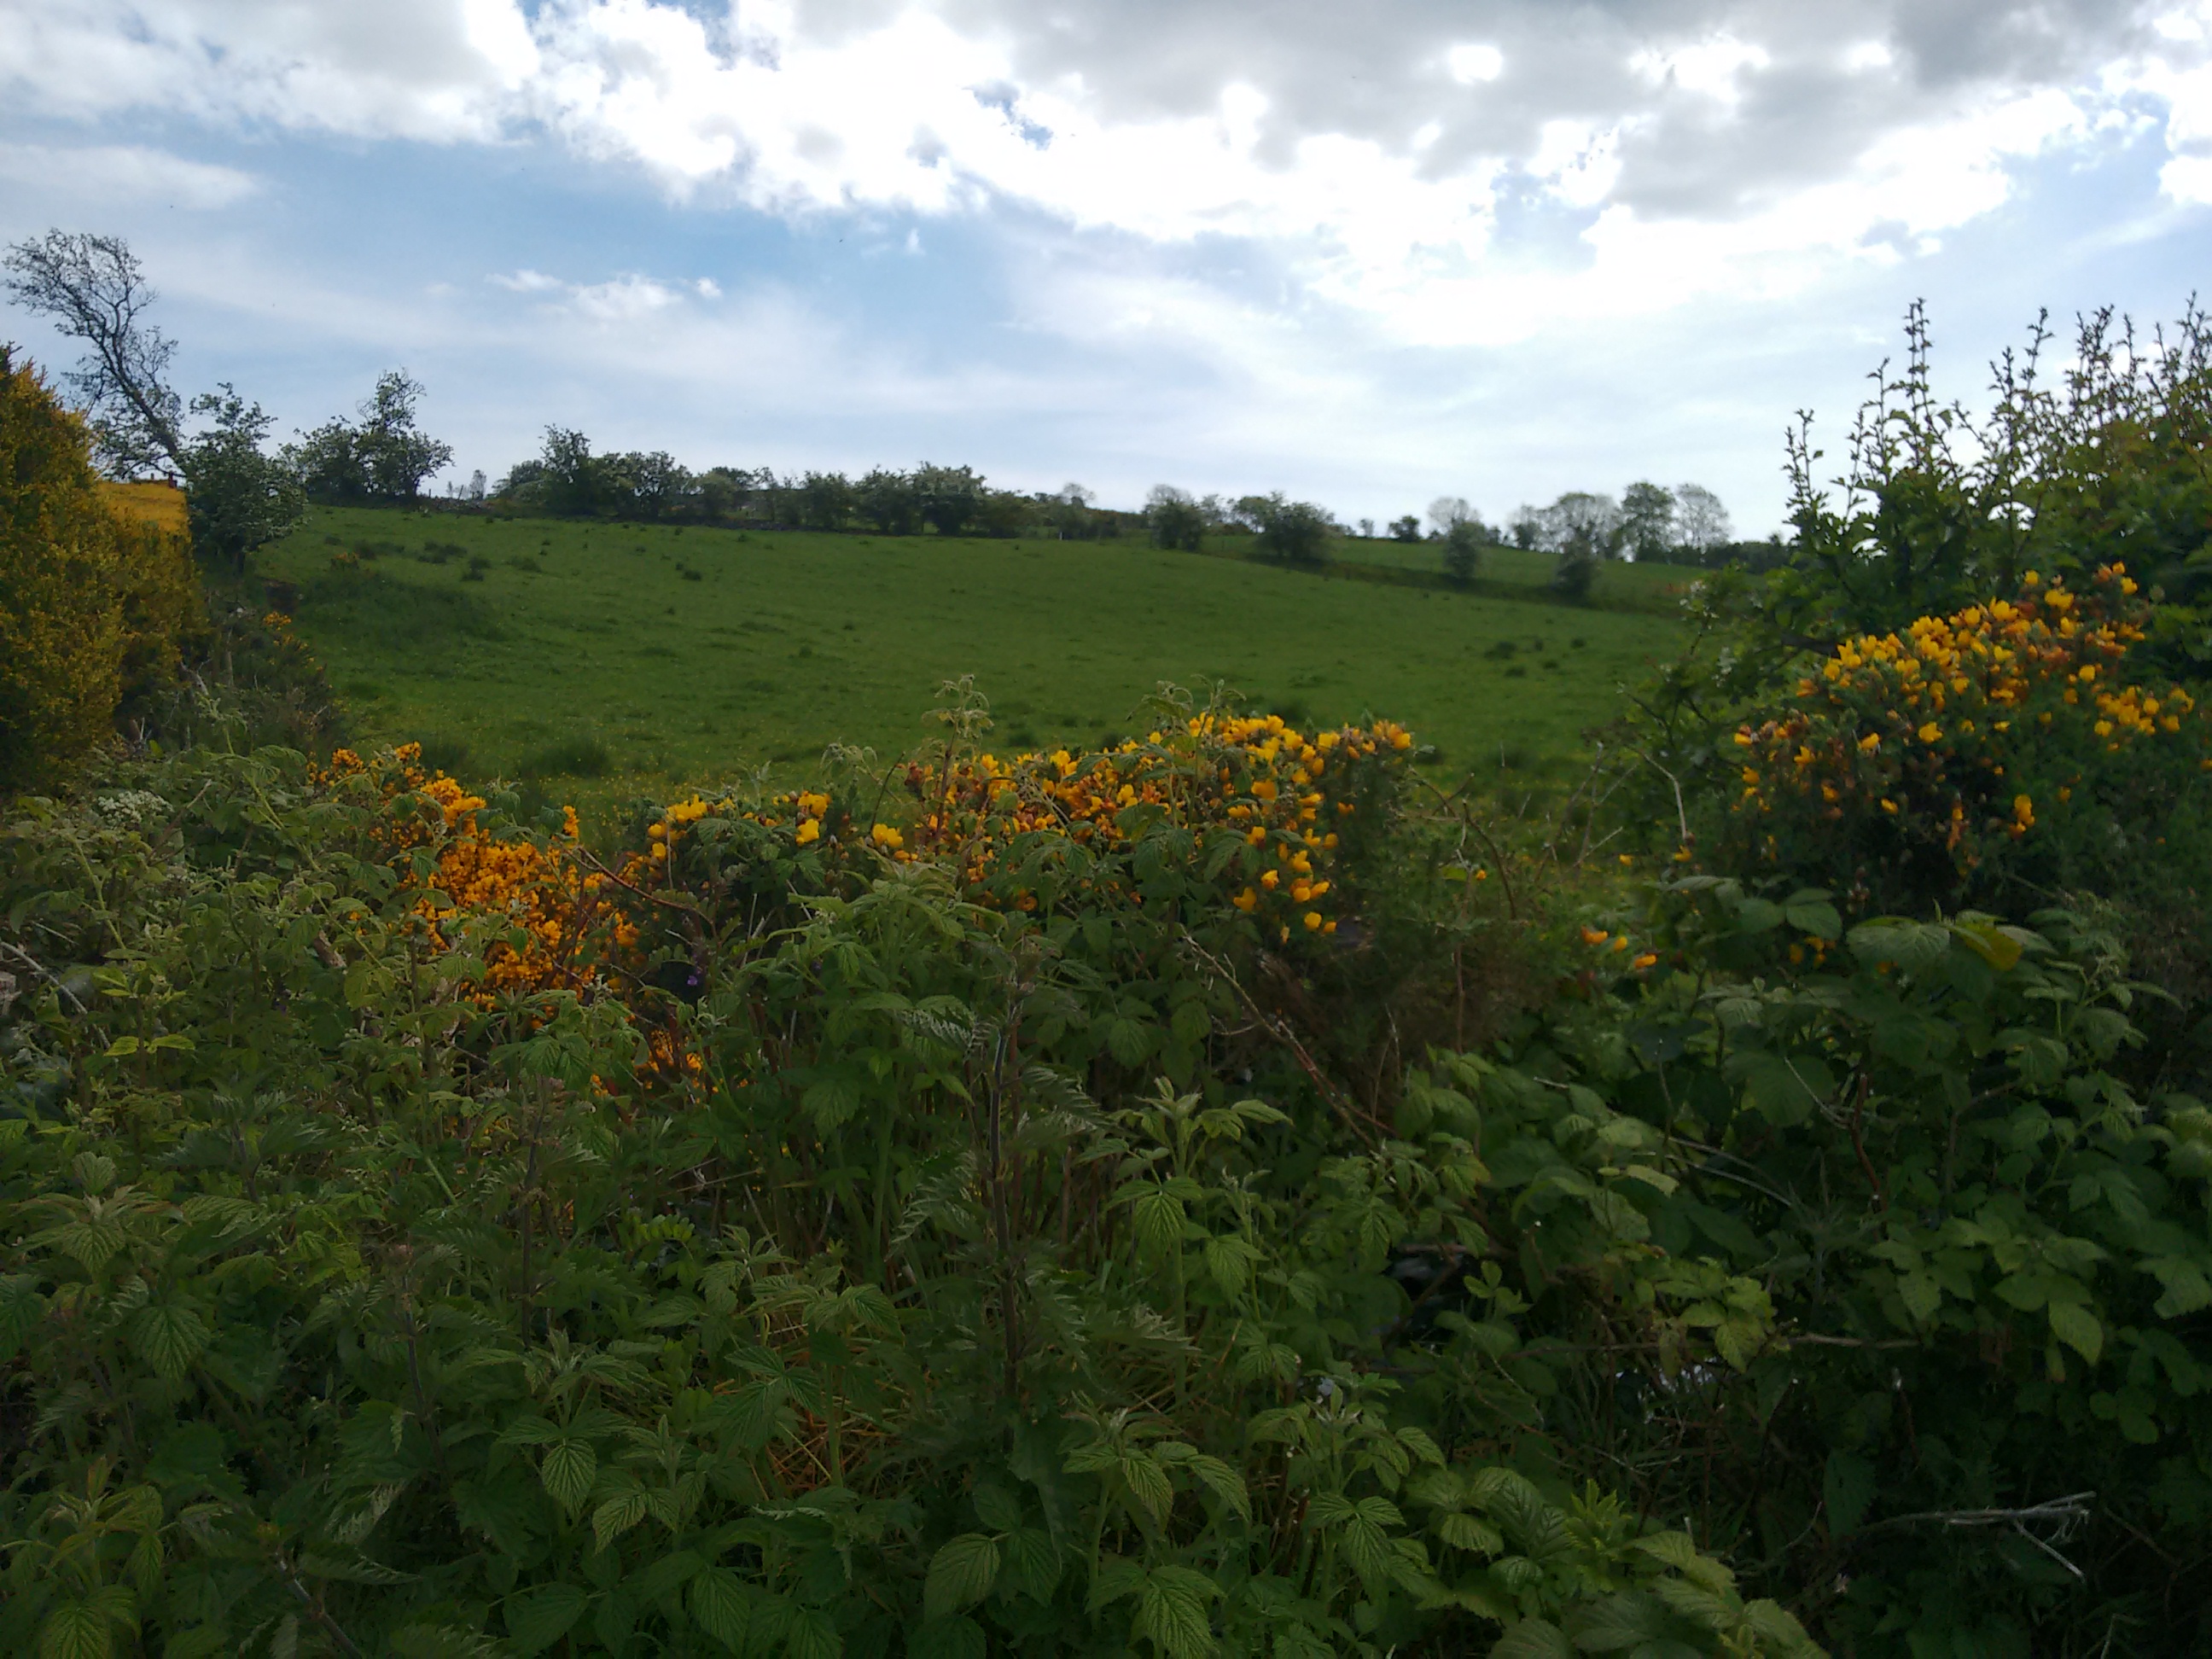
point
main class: Grassland
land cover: Grassland without tree/shrub cover
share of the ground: > 75 %
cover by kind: herbaceous plants 100 %
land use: Agriculture (excluding fallow land and kitchen gardens)
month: June
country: GB
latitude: 54.7086
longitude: -7.3950
